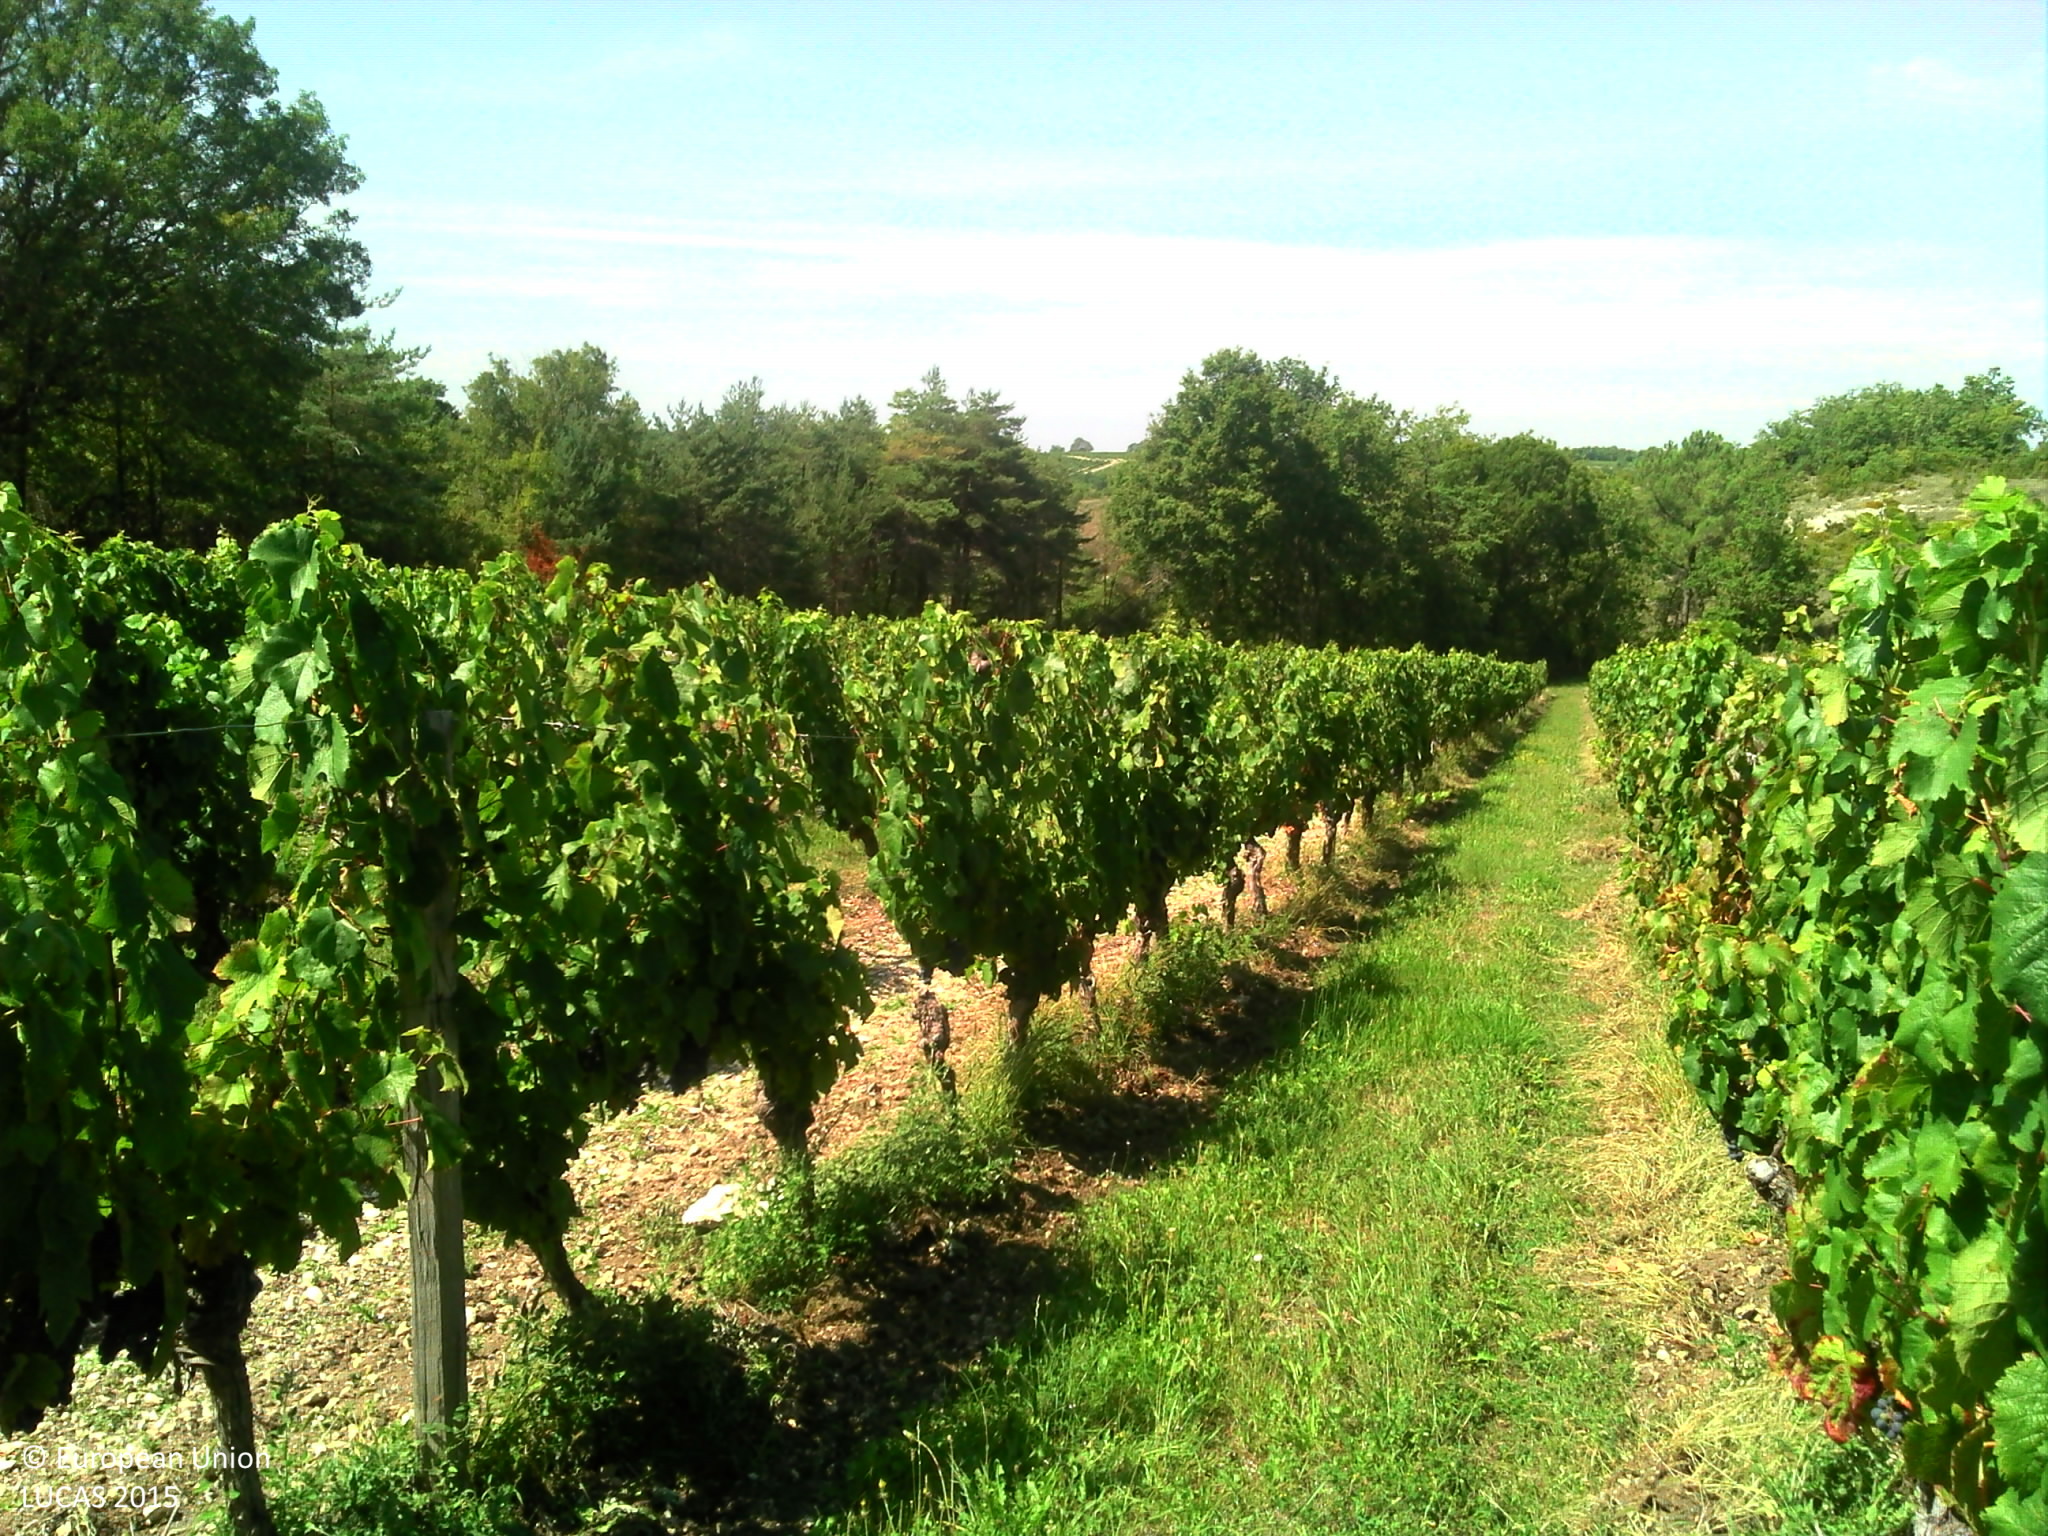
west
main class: Cropland
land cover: Vineyards
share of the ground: 25 - 50 %
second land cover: Grassland without tree/shrub cover
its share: 50 - 75 %
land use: Agriculture (excluding fallow land and kitchen gardens)
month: August
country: FR
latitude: 44.3771
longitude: 1.2245
